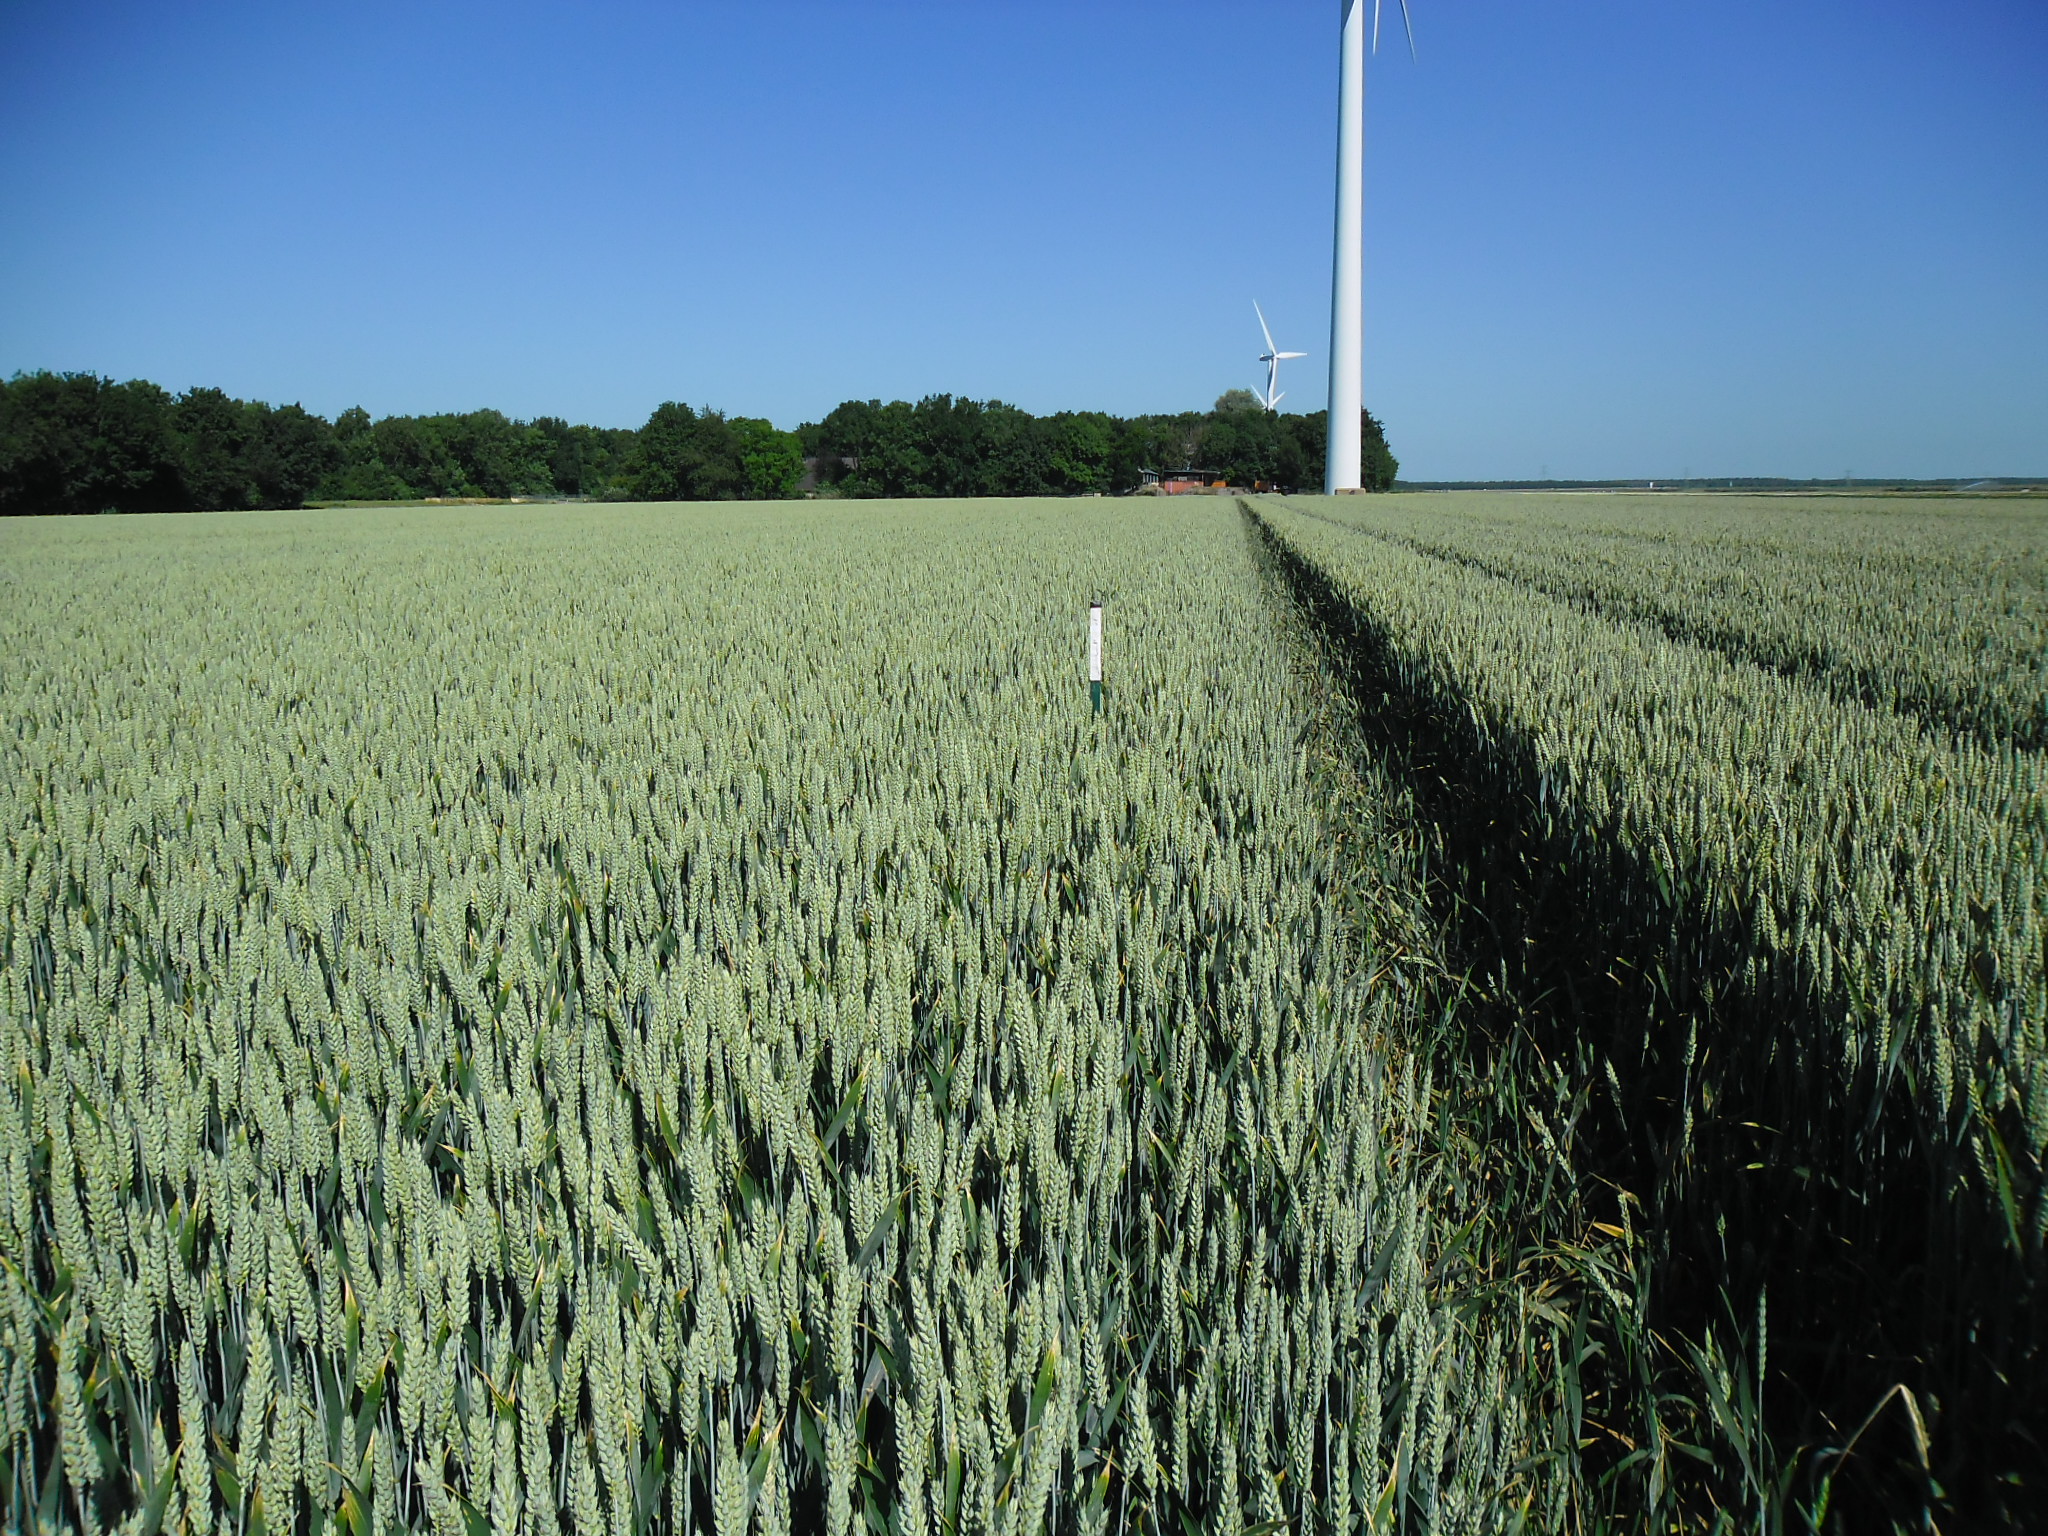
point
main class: Cropland
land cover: Common wheat
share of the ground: > 75 %
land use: Agriculture (excluding fallow land and kitchen gardens)
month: June
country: NL
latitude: 52.4165
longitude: 5.4551
